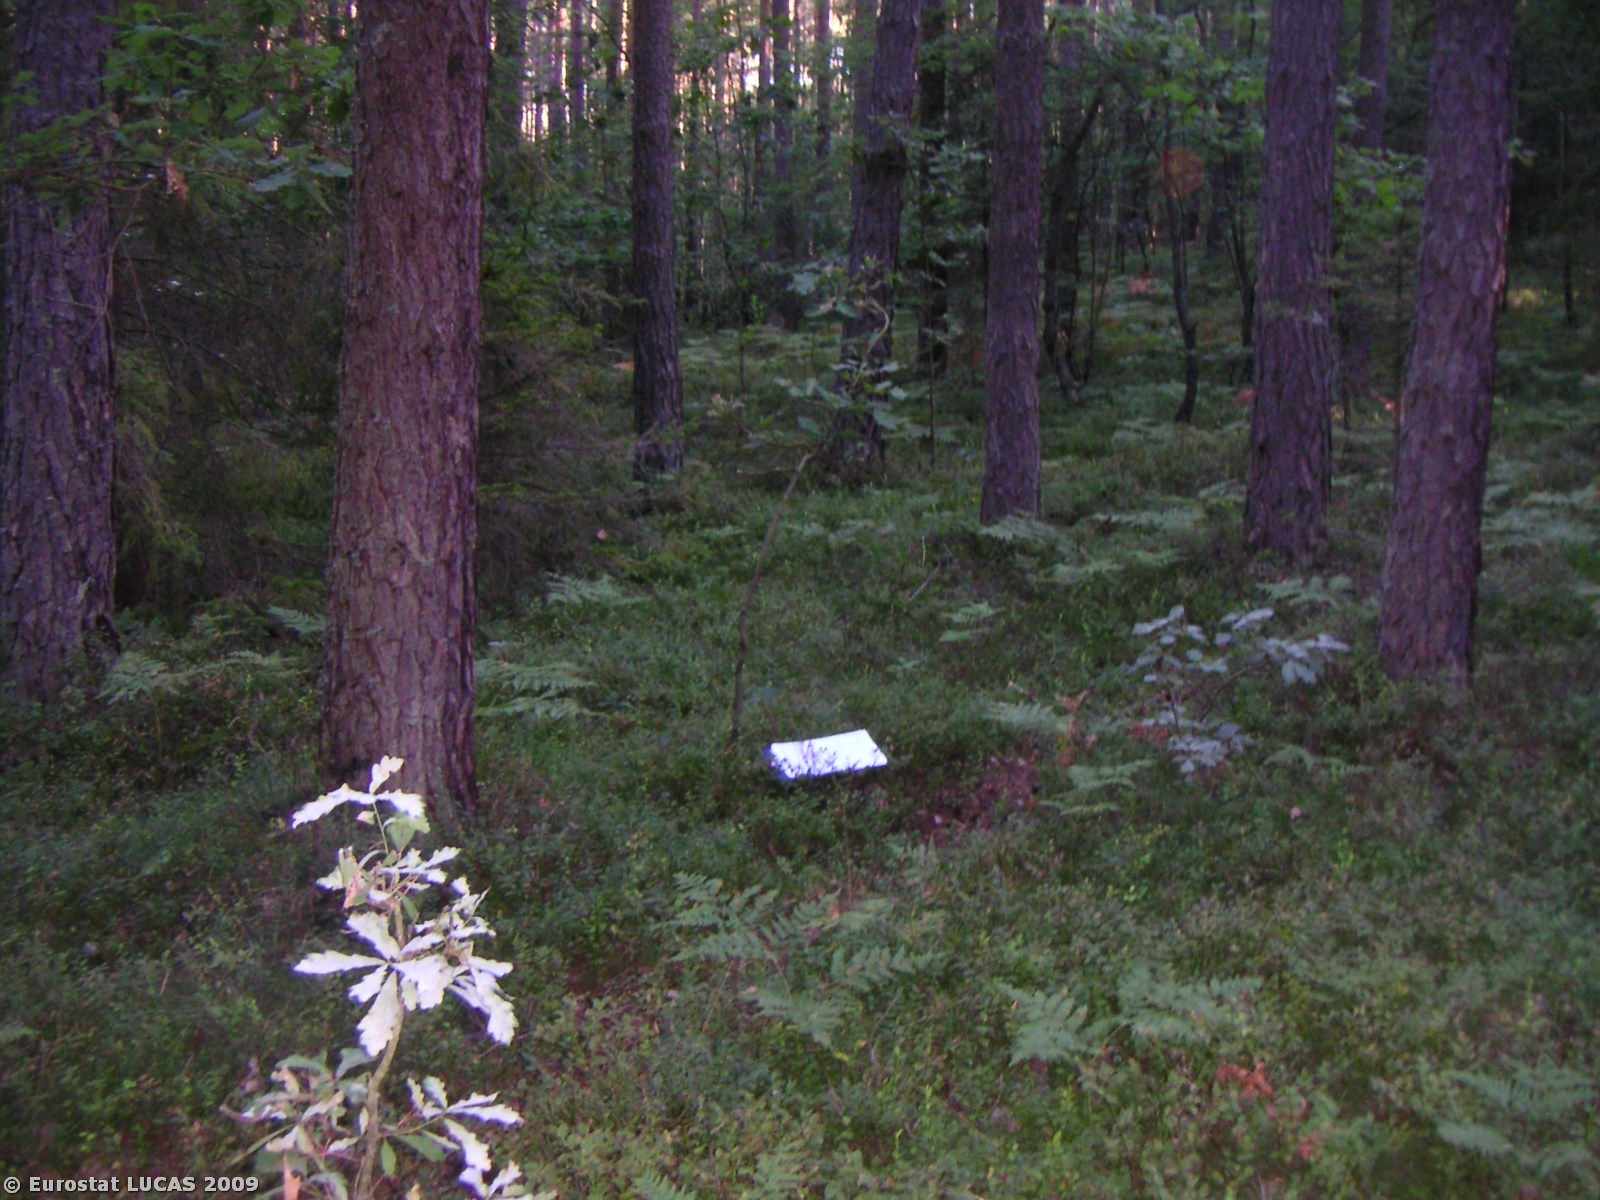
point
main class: Woodland
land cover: Coniferous woodland
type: hemiboreal forest and nemoral coniferous forest and mixed broadleaved-coniferous forest
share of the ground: > 75 %
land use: Forestry
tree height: > 5 m
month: August
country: PL
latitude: 50.6170
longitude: 18.8554
